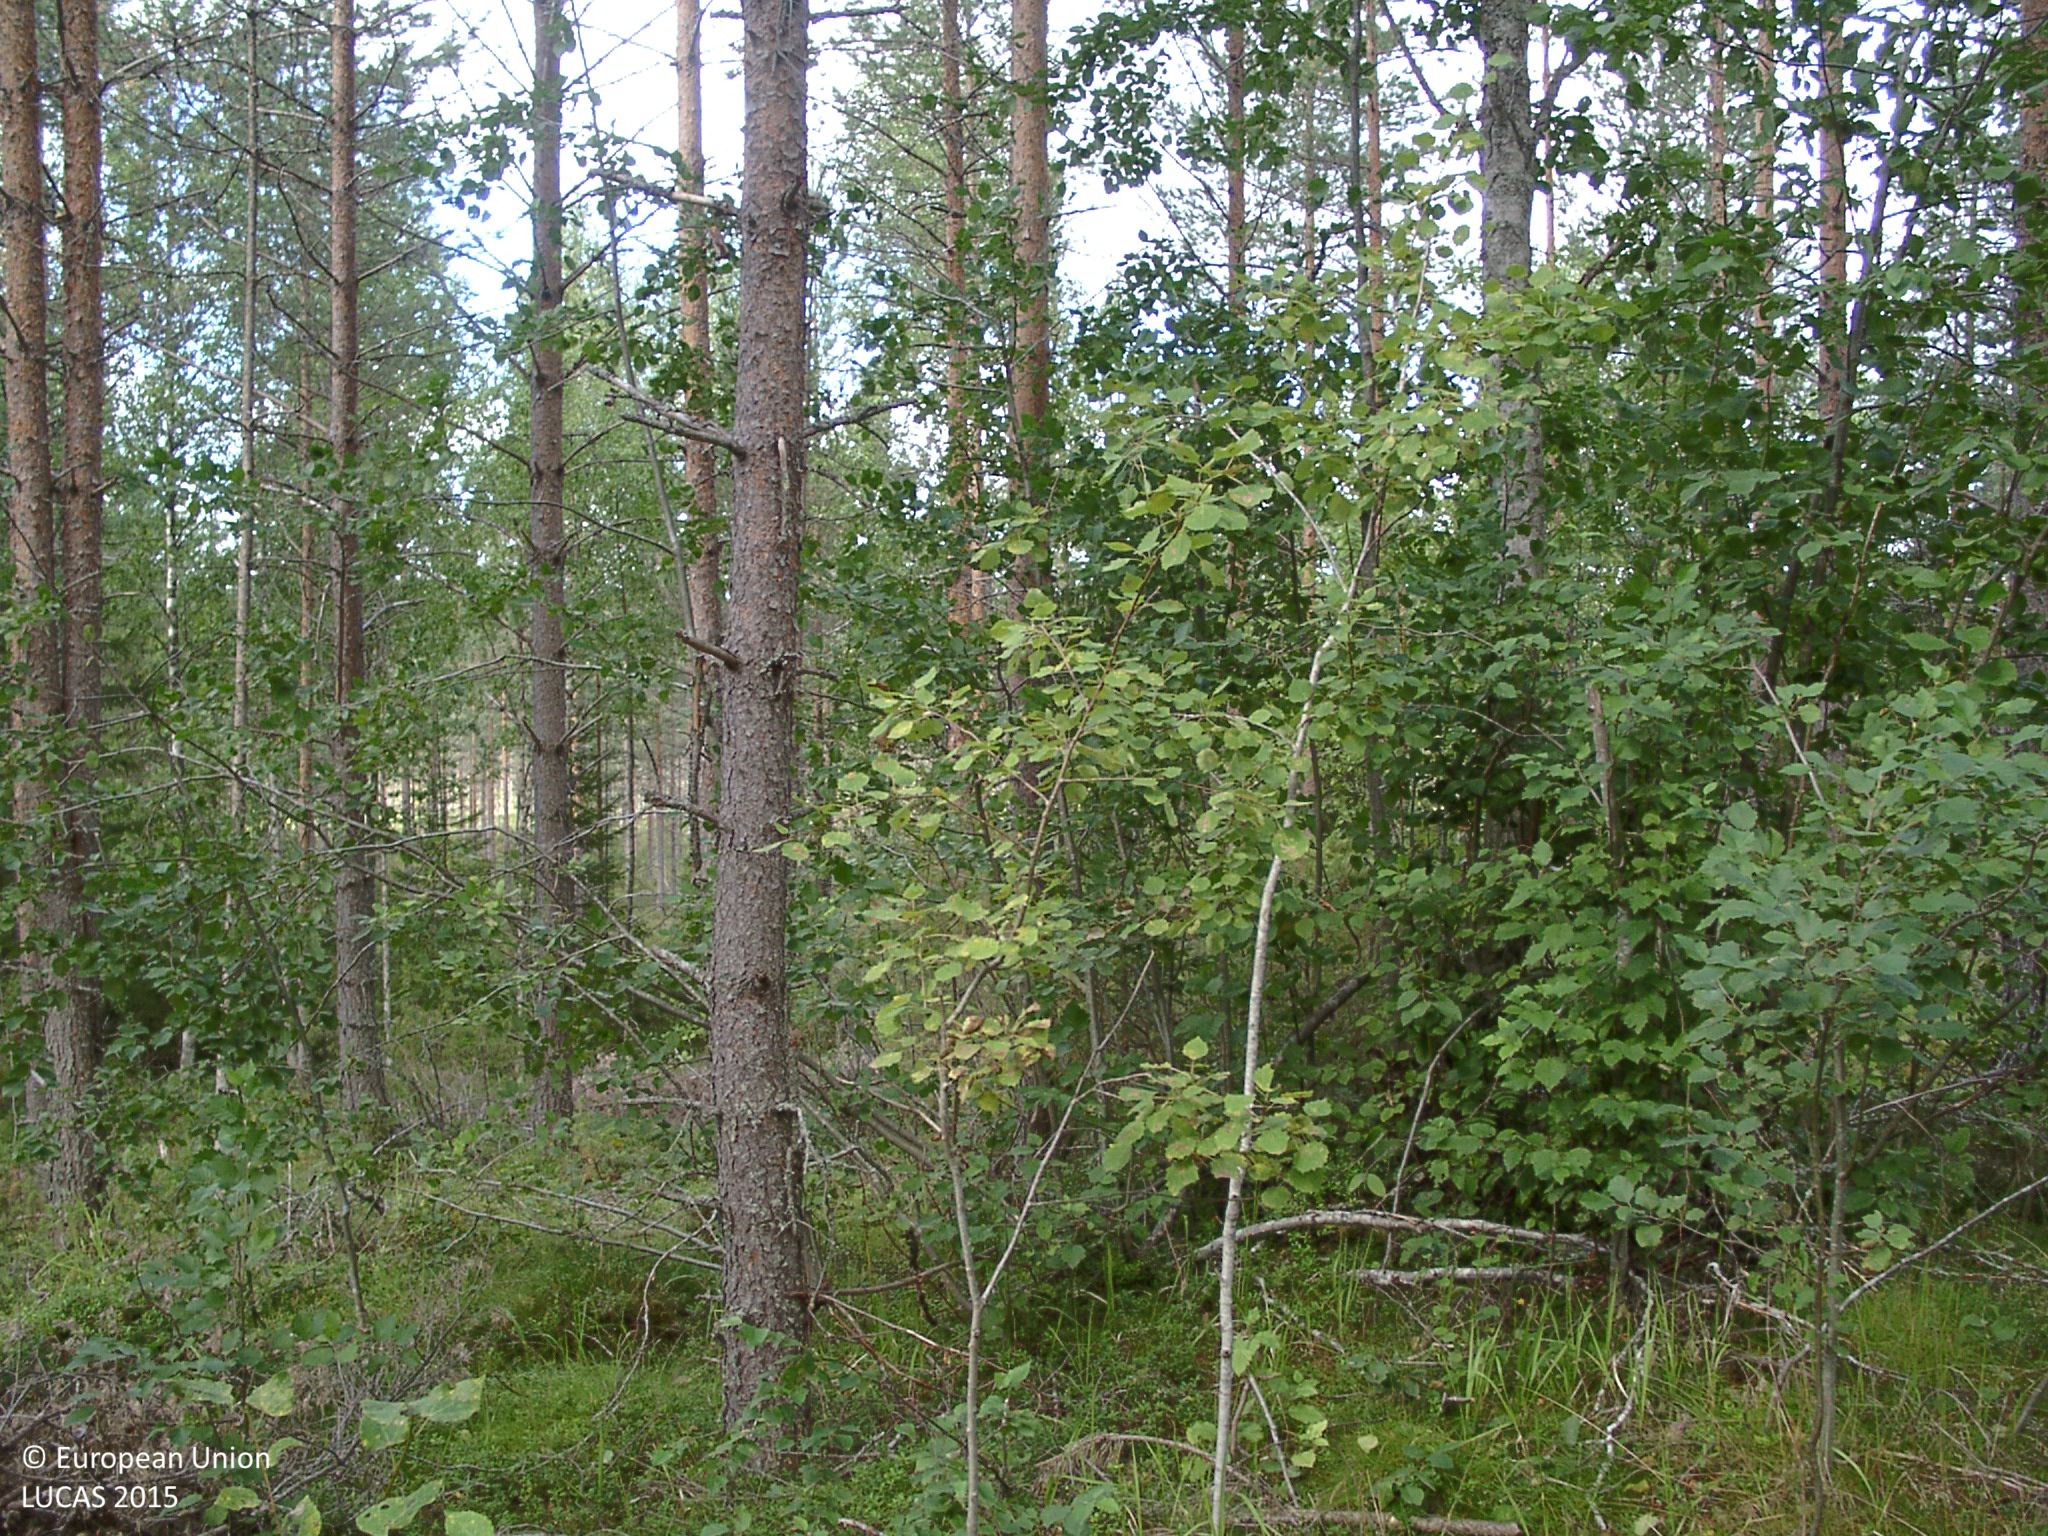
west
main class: Woodland
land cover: Pine dominated coniferous woodland
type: boreal forest
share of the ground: 50 - 75 %
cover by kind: coniferous forest trees 60 %, shrubs 10 %, herbaceous plants 10 %, lichens and mosses 10 %, broadleaved forest trees 5 %
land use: Forestry
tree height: > 5 m
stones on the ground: < 10 %
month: August
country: FI
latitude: 62.3331
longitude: 25.5389
